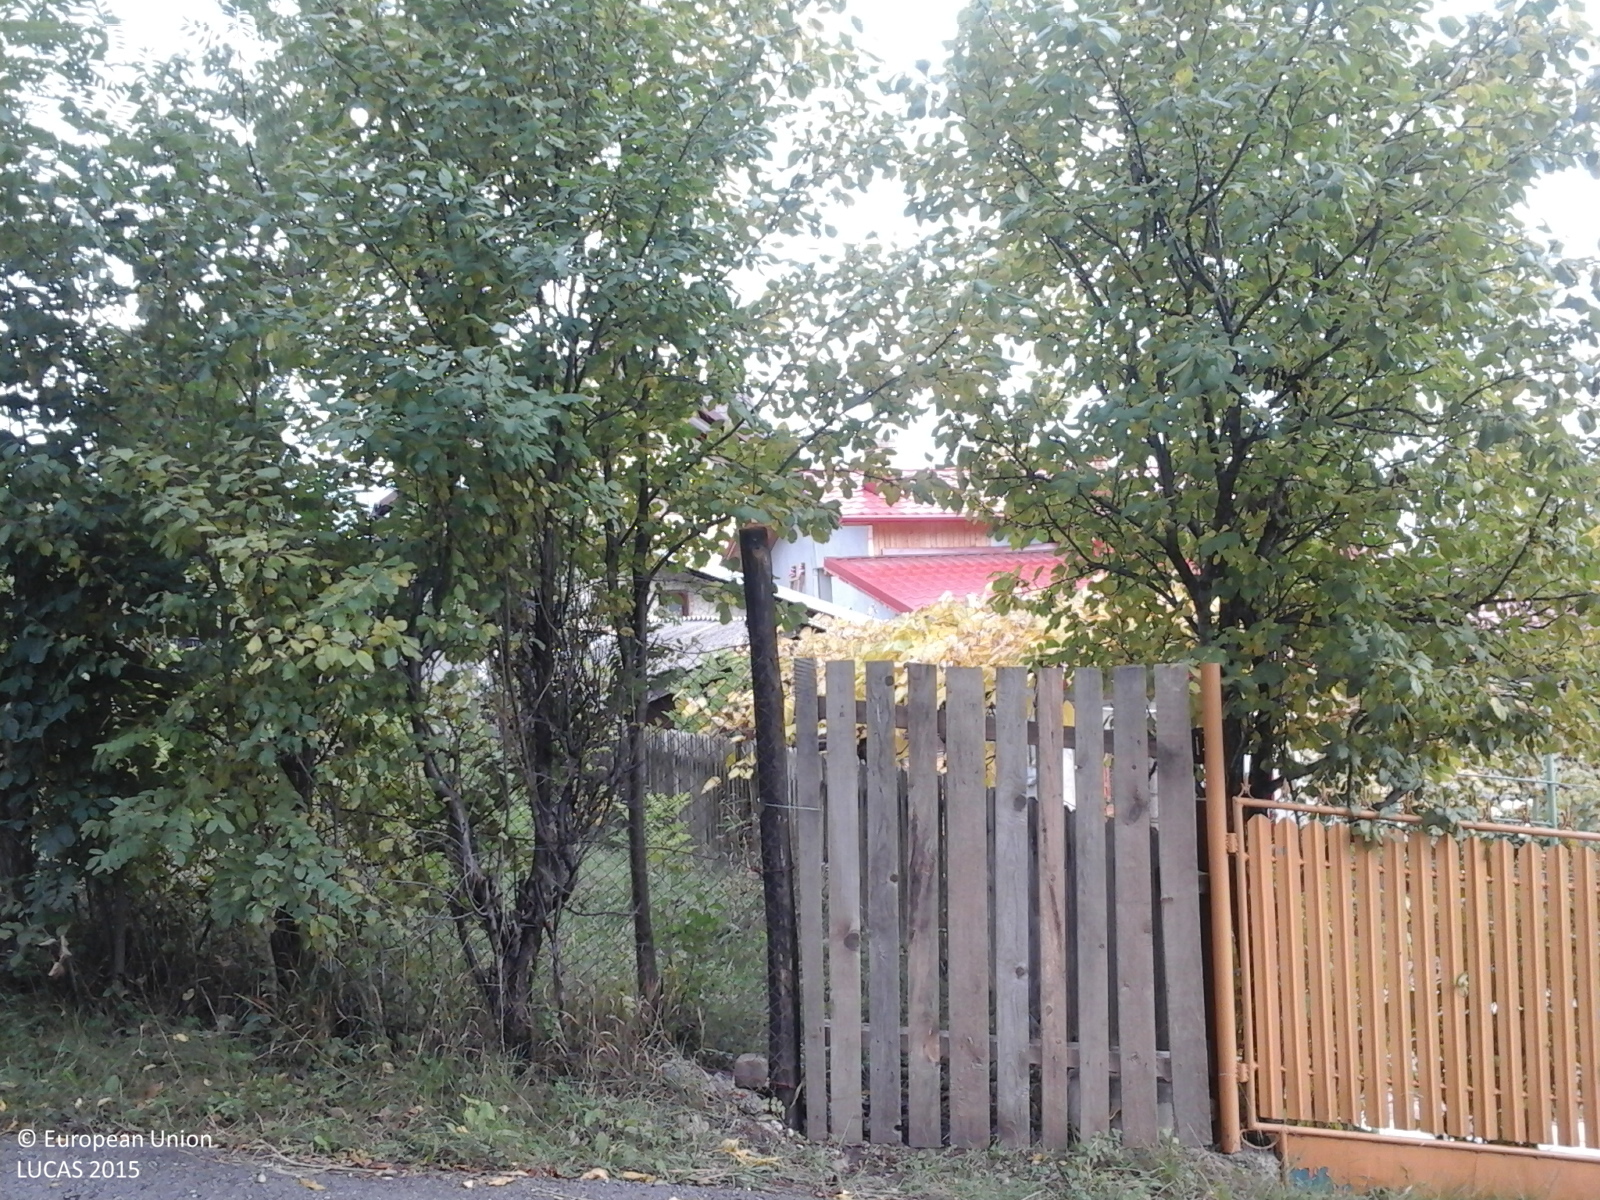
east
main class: Grassland
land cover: Grassland with sparse tree/shrub cover
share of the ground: > 75 %
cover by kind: herbaceous plants 85 %, shrubs 10 %, broadleaved forest trees 5 %
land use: Agriculture (excluding fallow land and kitchen gardens)
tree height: > 5 m
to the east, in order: Grassland with sparse tree/shrub cover; Artificial constructions in urban areas; Broadleaved woodland
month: October
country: RO
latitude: 45.1448
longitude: 25.7075
